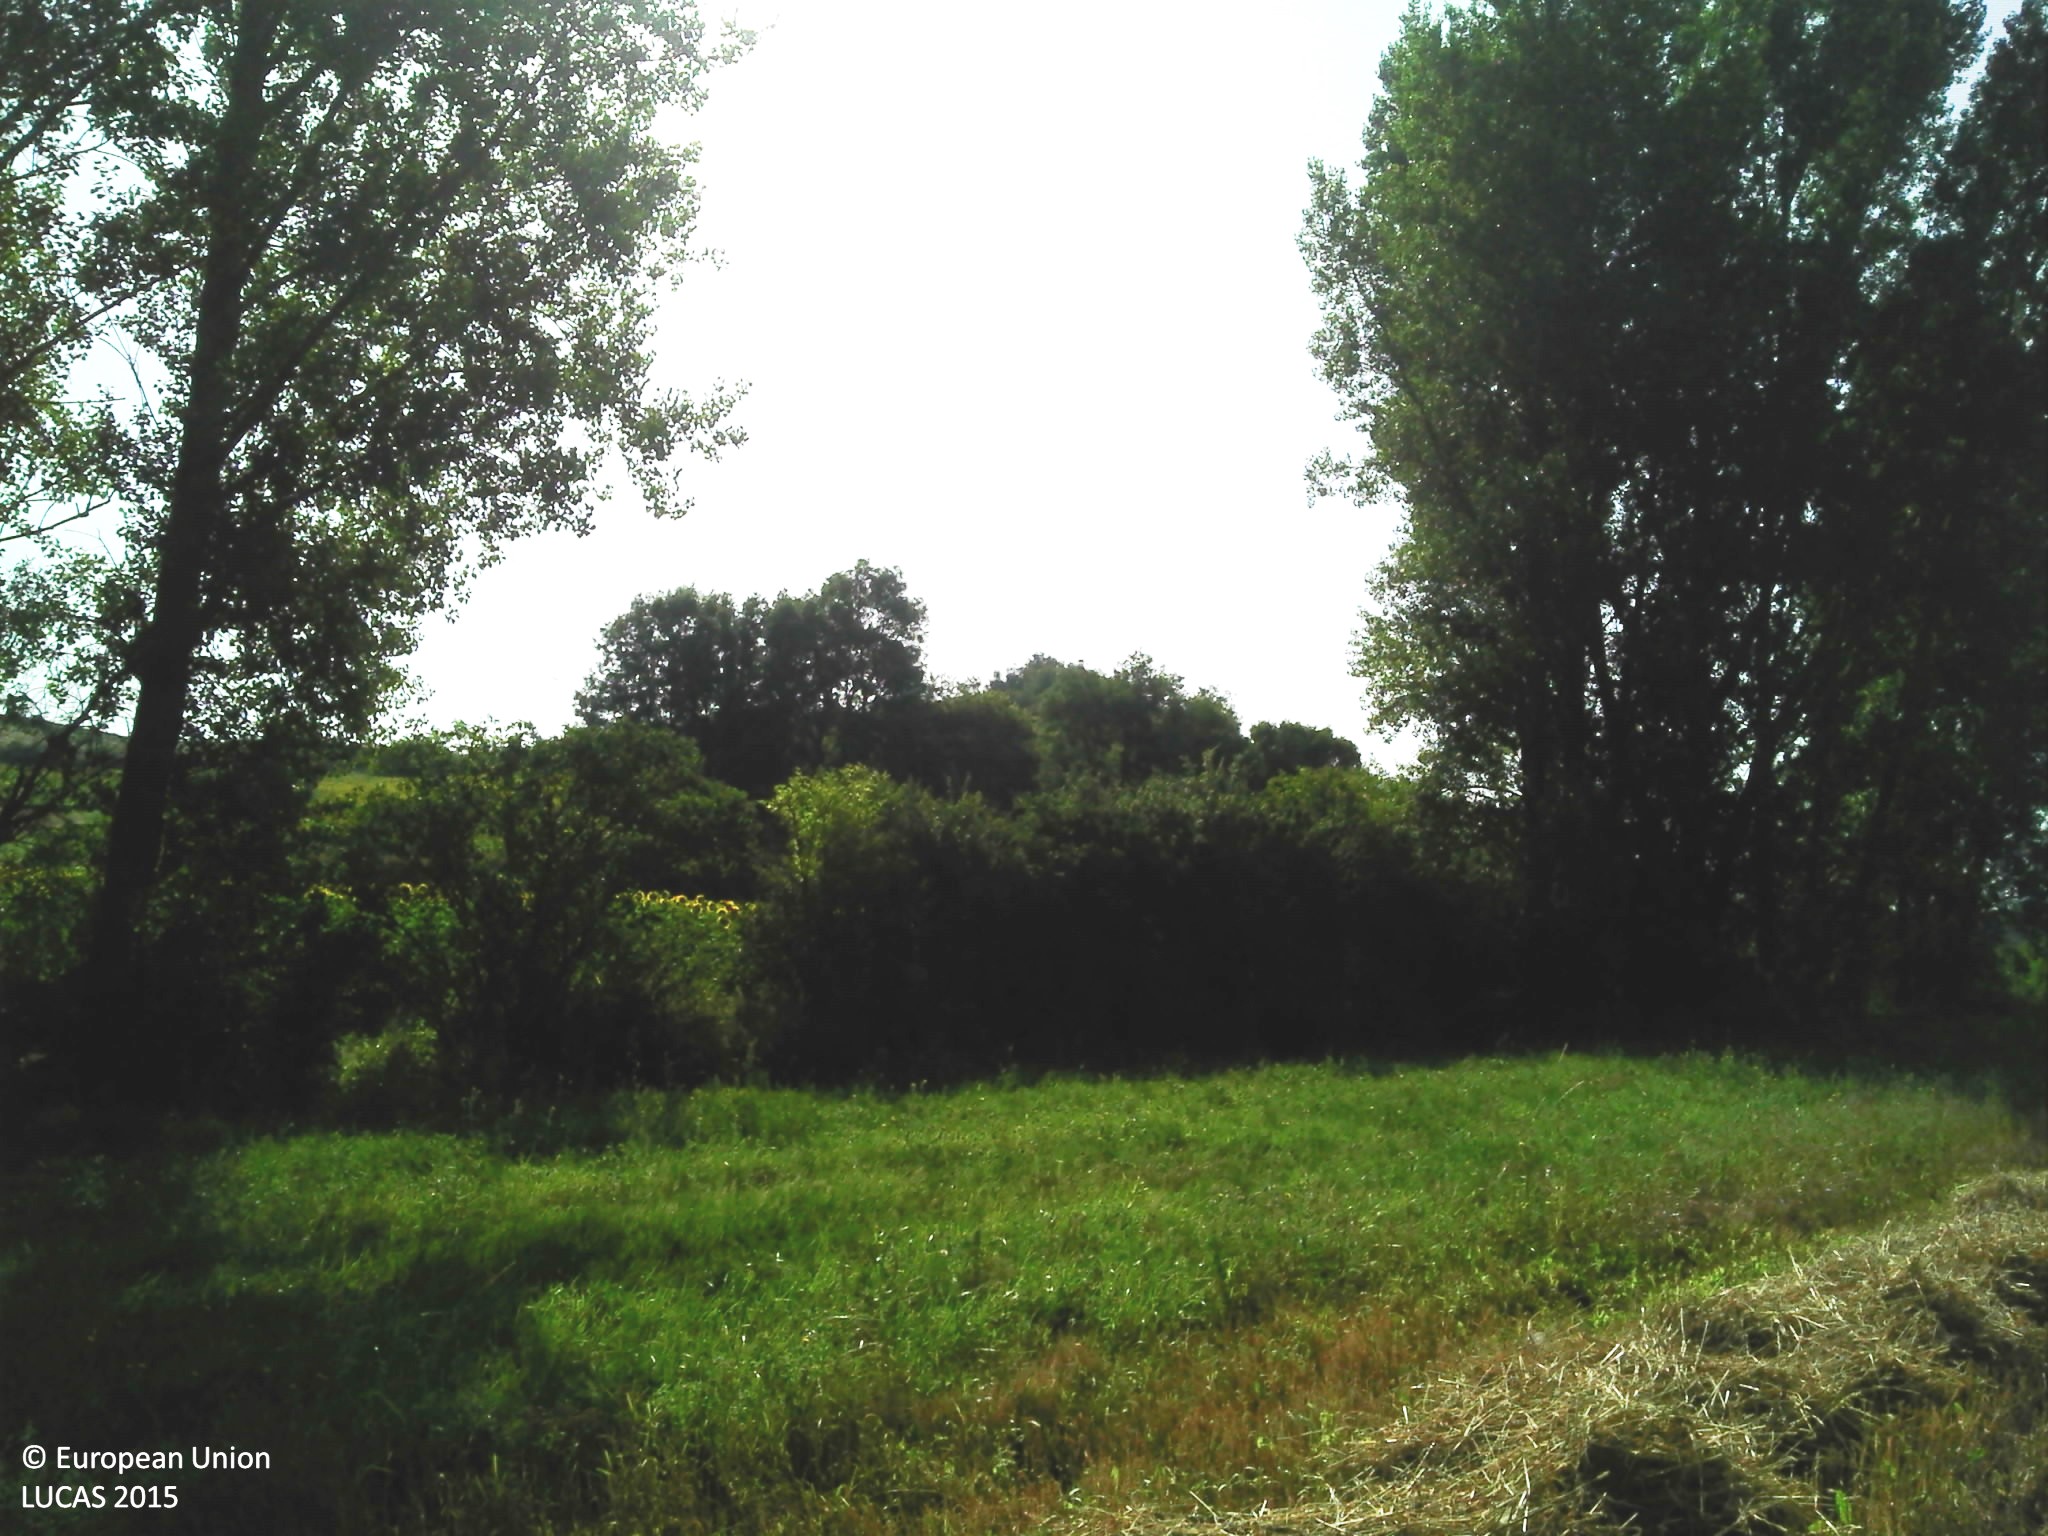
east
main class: Cropland
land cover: Durum wheat
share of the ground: > 75 %
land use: Agriculture (excluding fallow land and kitchen gardens)
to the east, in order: Durum wheat; Grassland without tree/shrub cover; Rivers and streams; Abandoned hedges; Grass margins; Sunflower; Grass margins; Fences; Tracks; Broadleaved woodland; Fences; Sunflower; Shrubland without tree cover
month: July
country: FR
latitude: 43.2490
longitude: 1.3951
